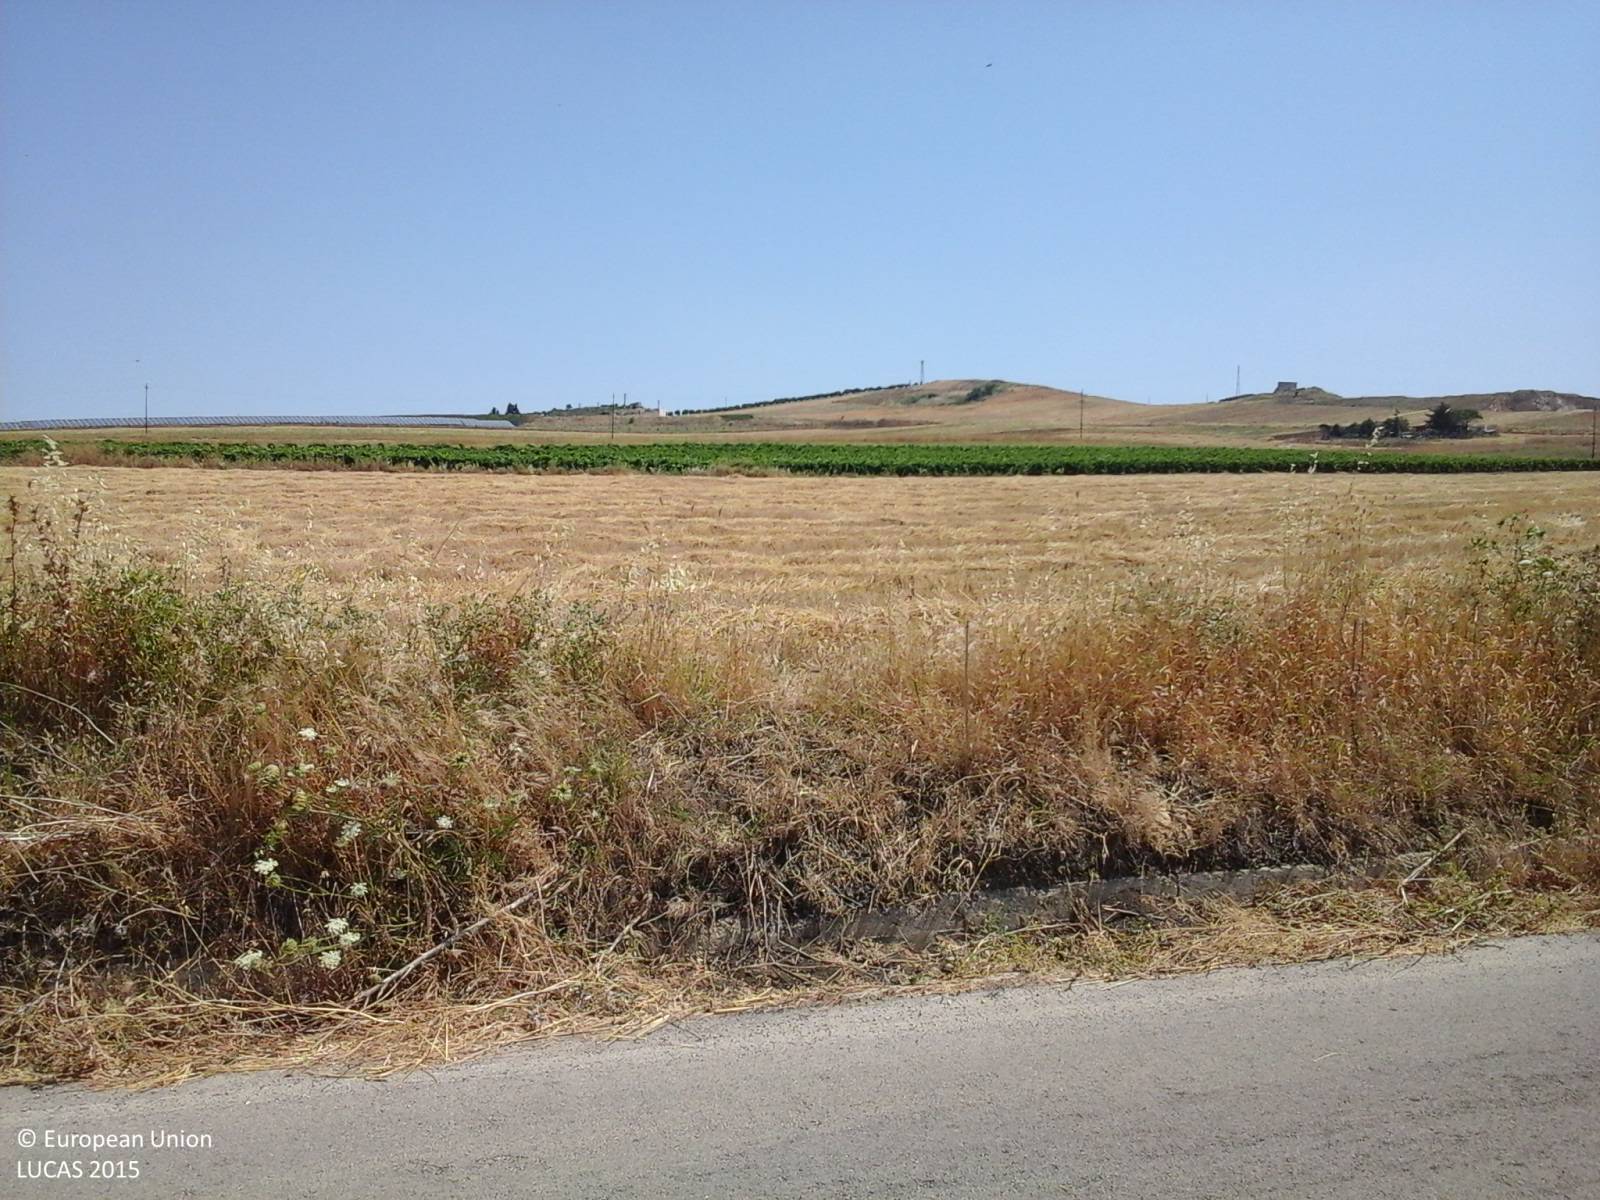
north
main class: Grassland
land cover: Spontaneously vegetated surfaces
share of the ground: > 75 %
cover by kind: herbaceous plants 100 %
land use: Fallow land
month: July
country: IT
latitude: 37.8227
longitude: 13.1465
